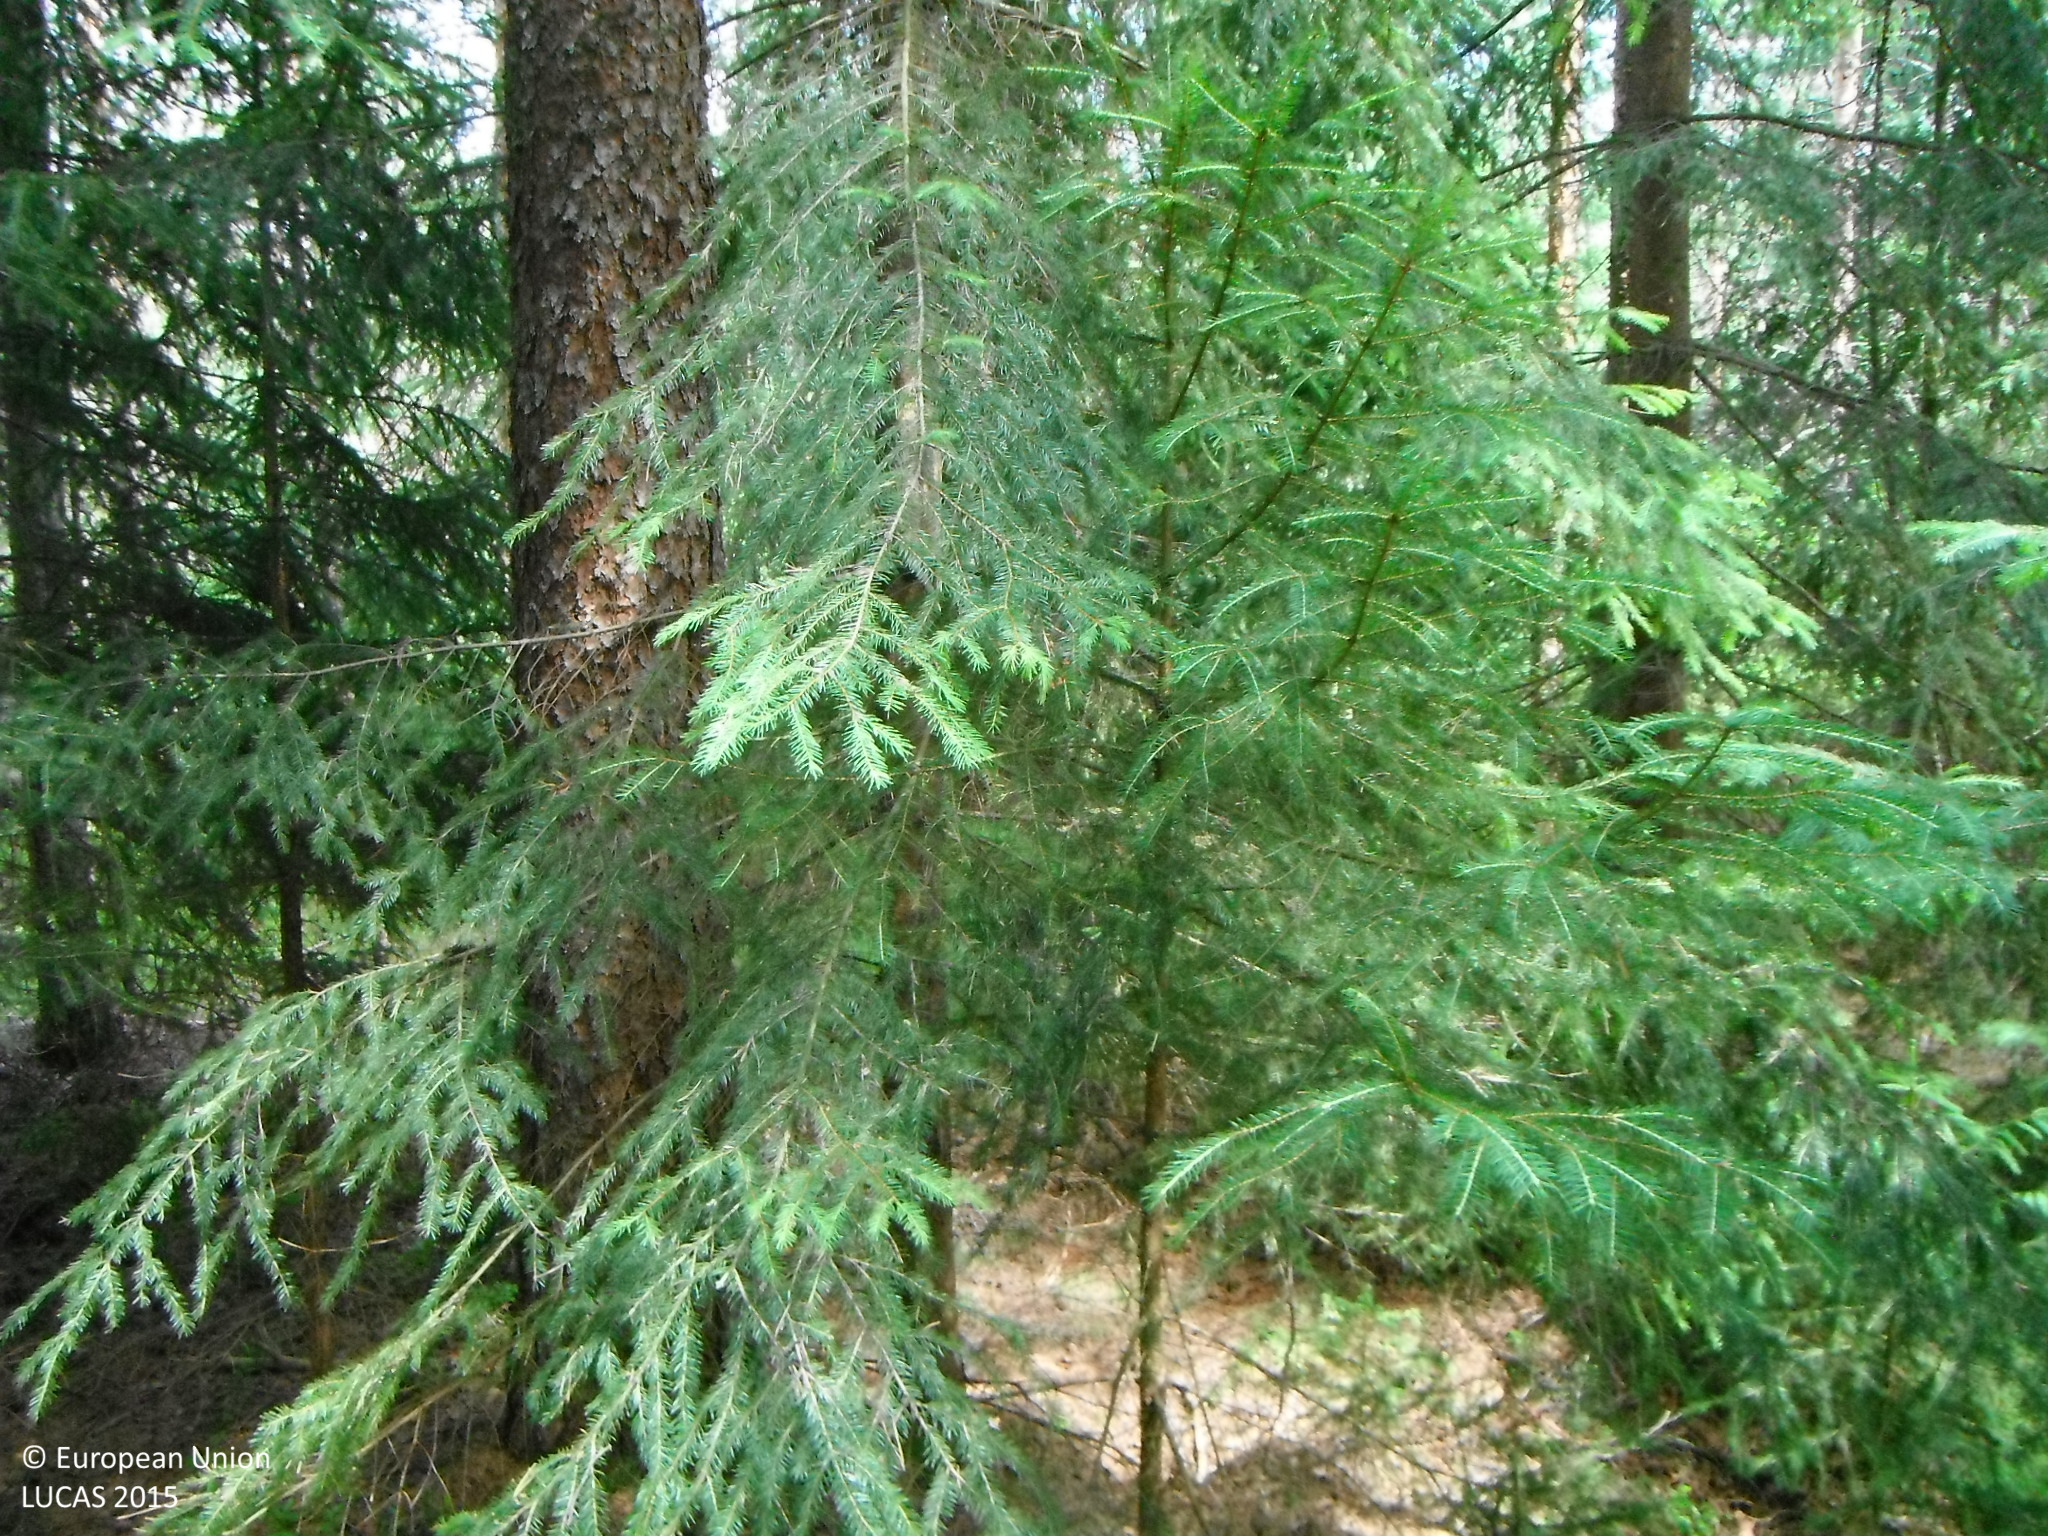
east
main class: Woodland
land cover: Spruce dominated coniferous woodland
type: alpine coniferous forest
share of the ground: > 75 %
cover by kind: coniferous forest trees 100 %
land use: Forestry
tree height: > 5 m
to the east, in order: Spruce dominated coniferous woodland; Pine dominated coniferous woodland; Spruce dominated coniferous woodland
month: July
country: SK
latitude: 49.4012
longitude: 19.7717
